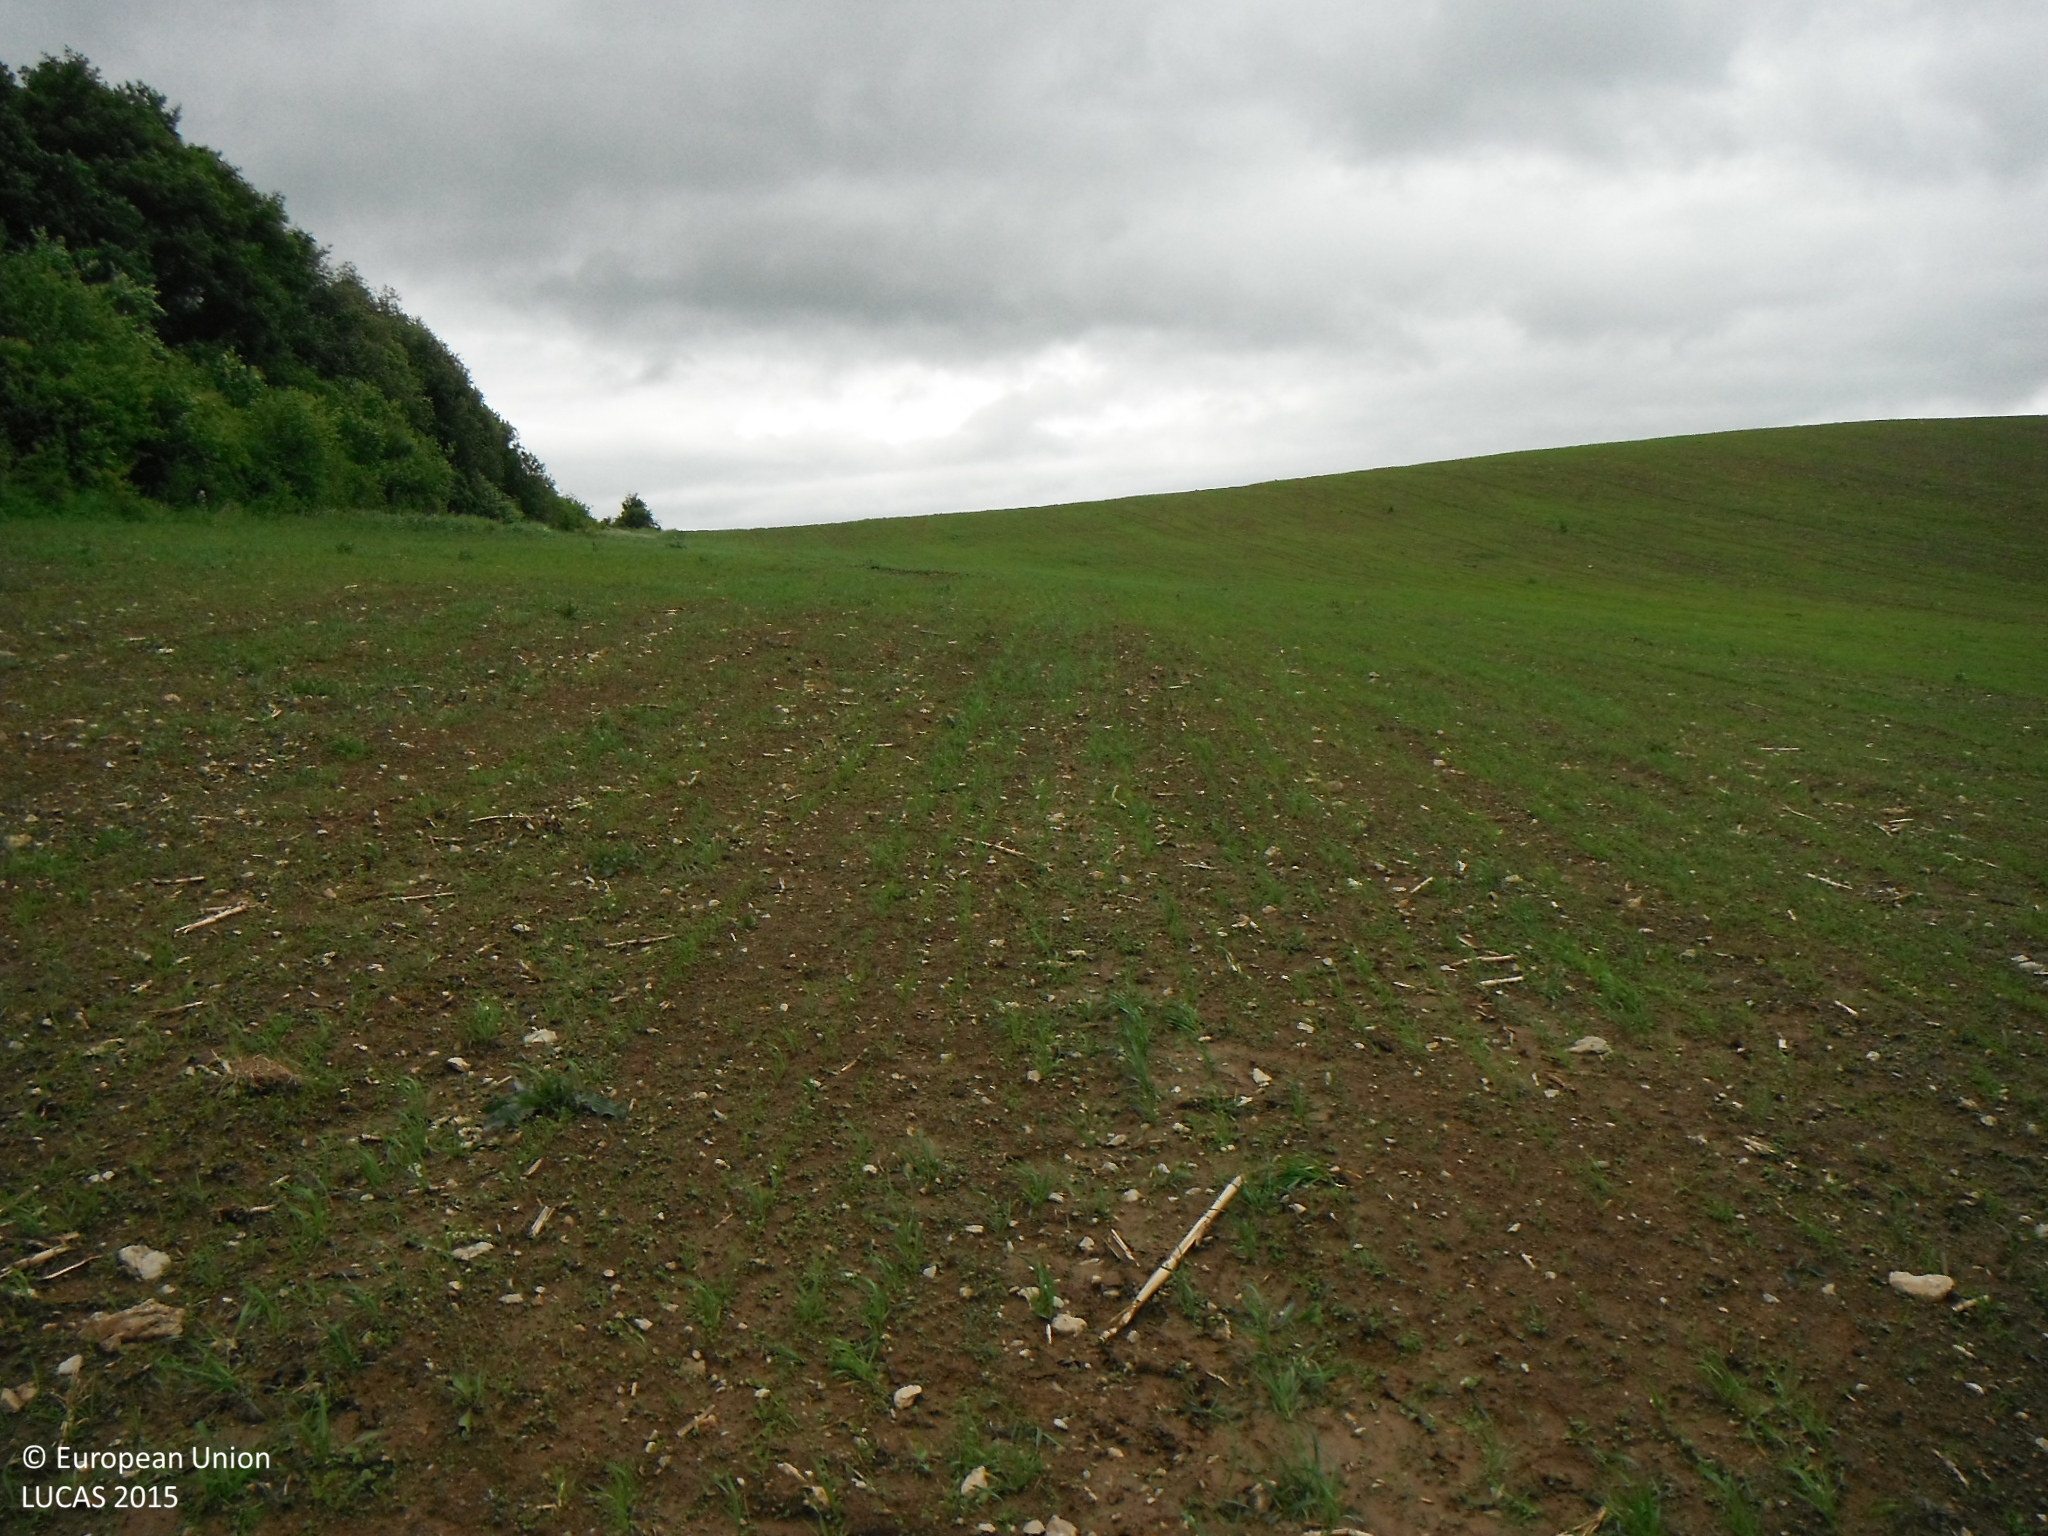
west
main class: Cropland
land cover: Common wheat
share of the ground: 25 - 50 %
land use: Agriculture (excluding fallow land and kitchen gardens)
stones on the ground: 10 - 25 %
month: May
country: SK
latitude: 49.0821
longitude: 19.0448
